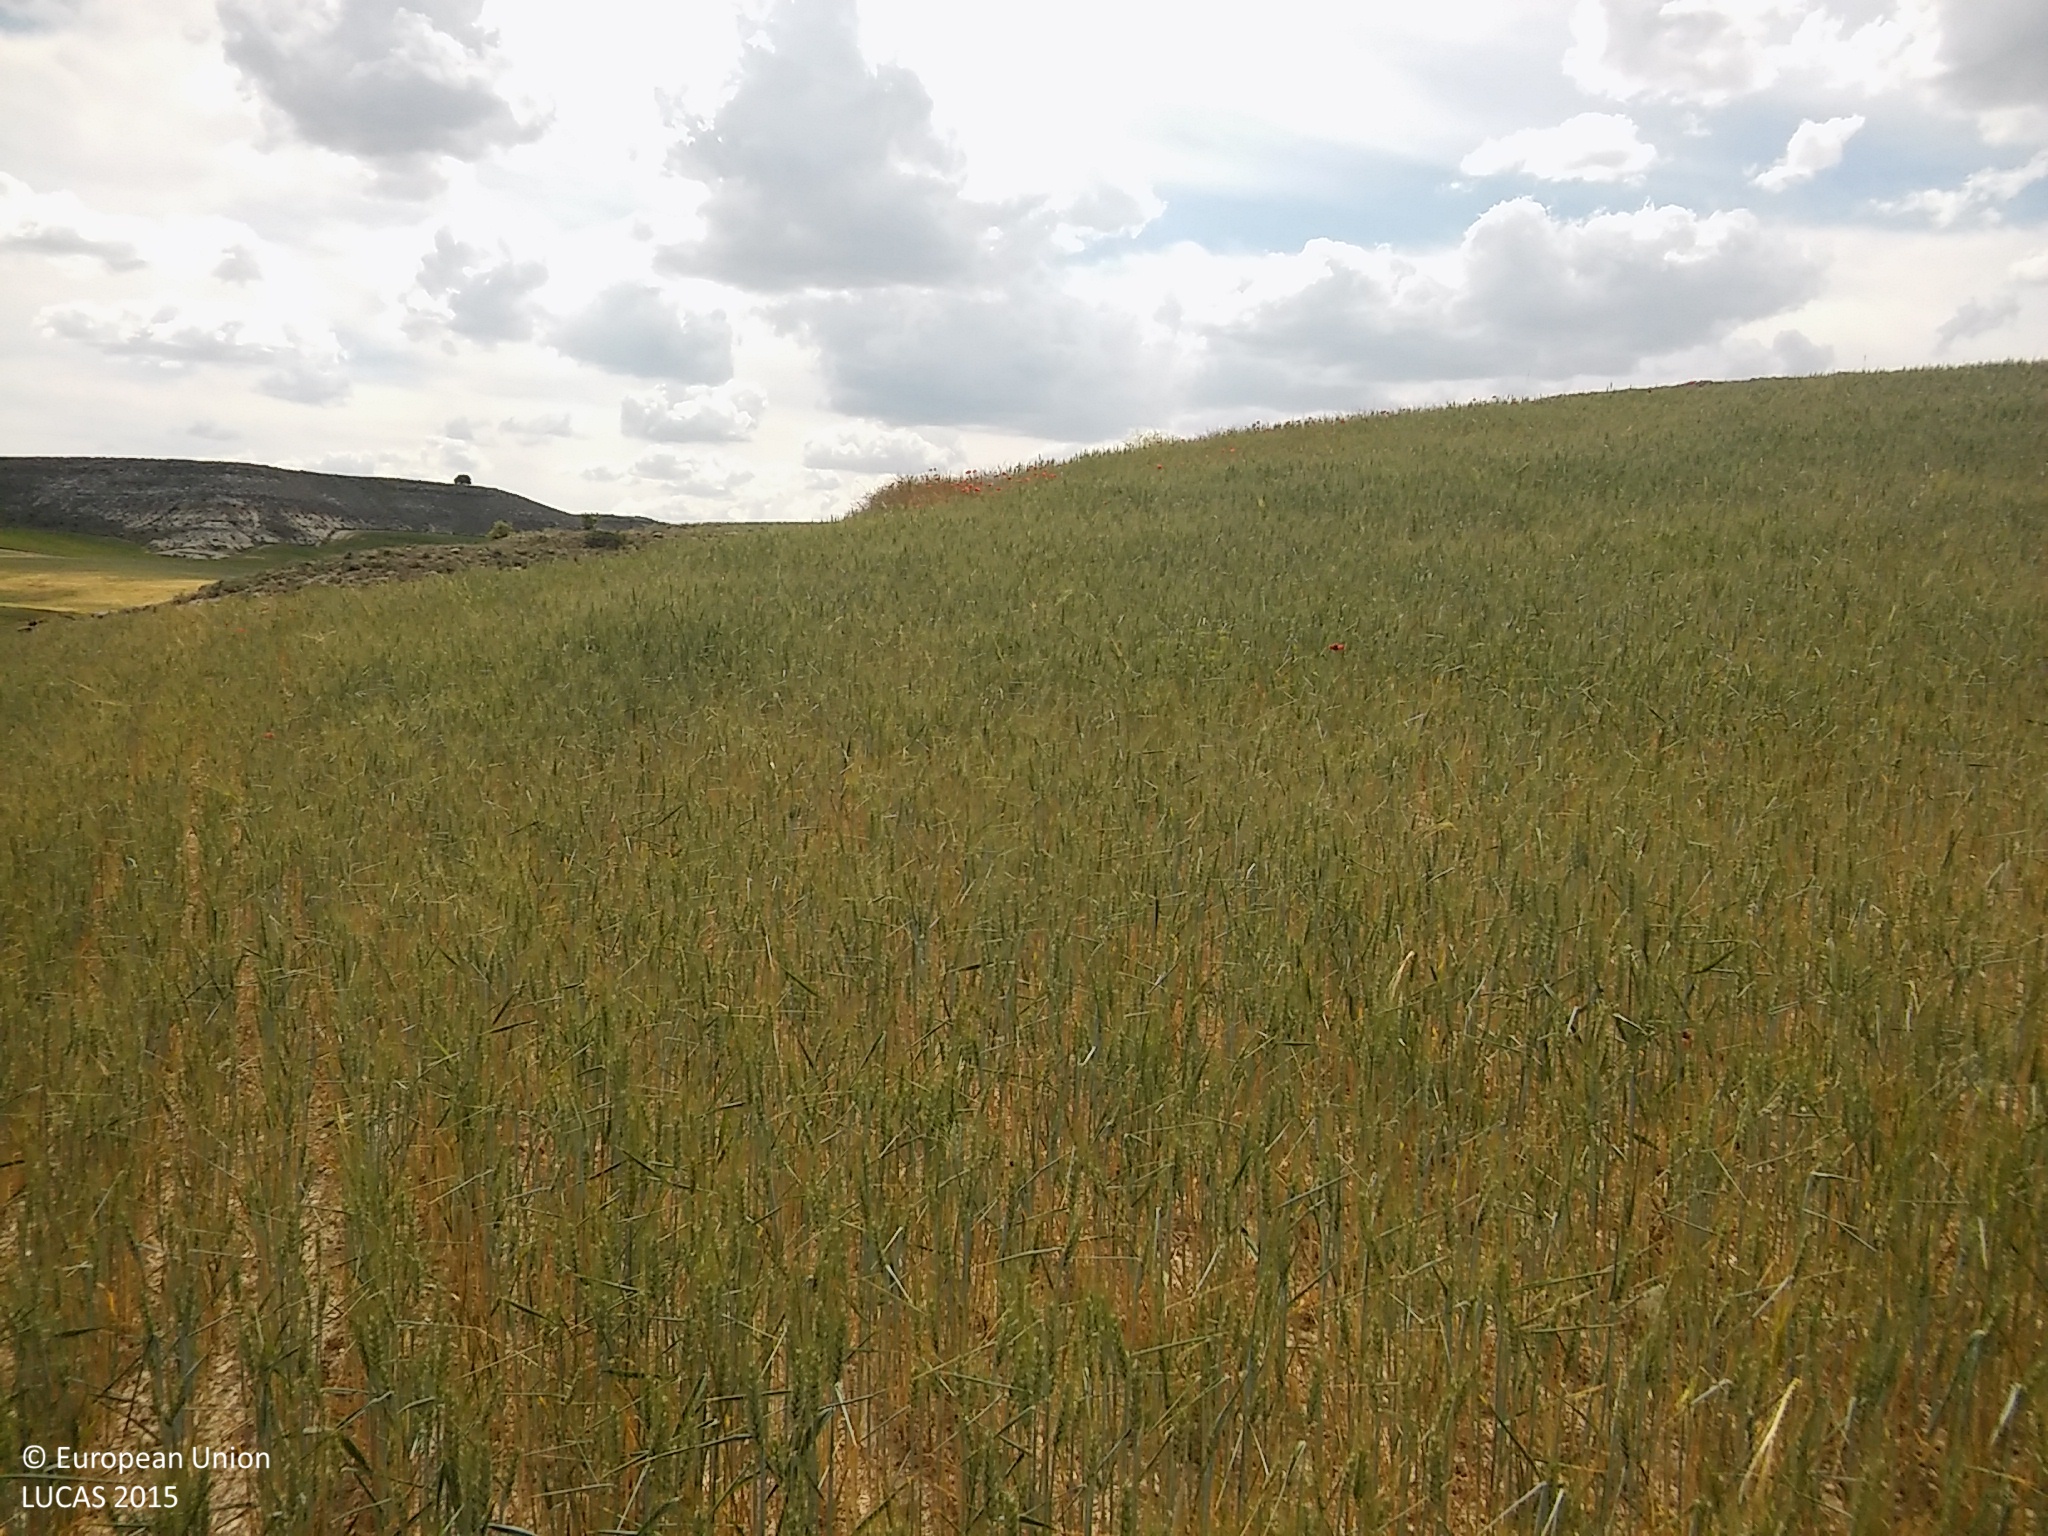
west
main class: Cropland
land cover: Common wheat
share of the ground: > 75 %
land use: Agriculture (excluding fallow land and kitchen gardens)
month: June
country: ES
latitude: 41.5893
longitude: -3.8374
